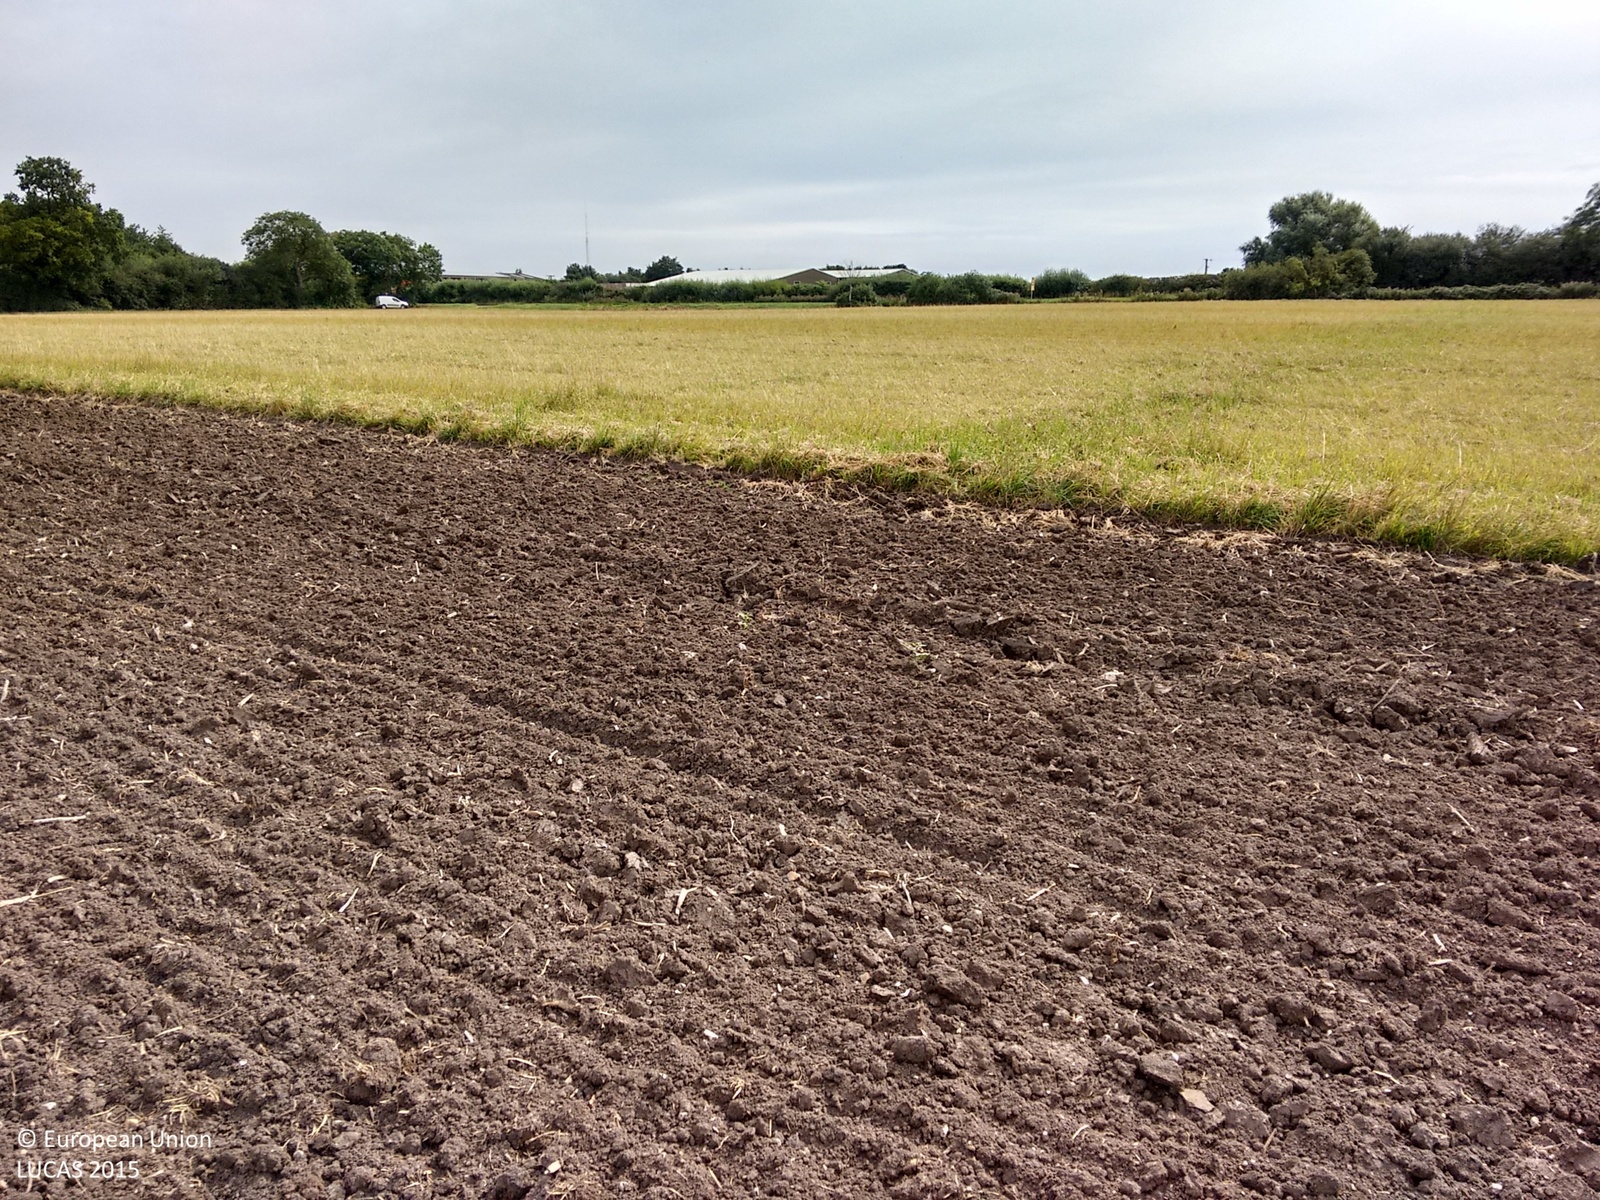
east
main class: Cropland
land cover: Common wheat
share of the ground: > 75 %
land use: Agriculture (excluding fallow land and kitchen gardens)
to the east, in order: Common wheat; Other bare soil; Grassland without tree/shrub cover; Ditches and canals; Grass margins; Paved roads, cycling and walking lanes; Grass margins; Ditches and canals; Abandoned hedges; Artificial constructions in urban areas
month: August
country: GB
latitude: 52.5715
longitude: 0.4553
